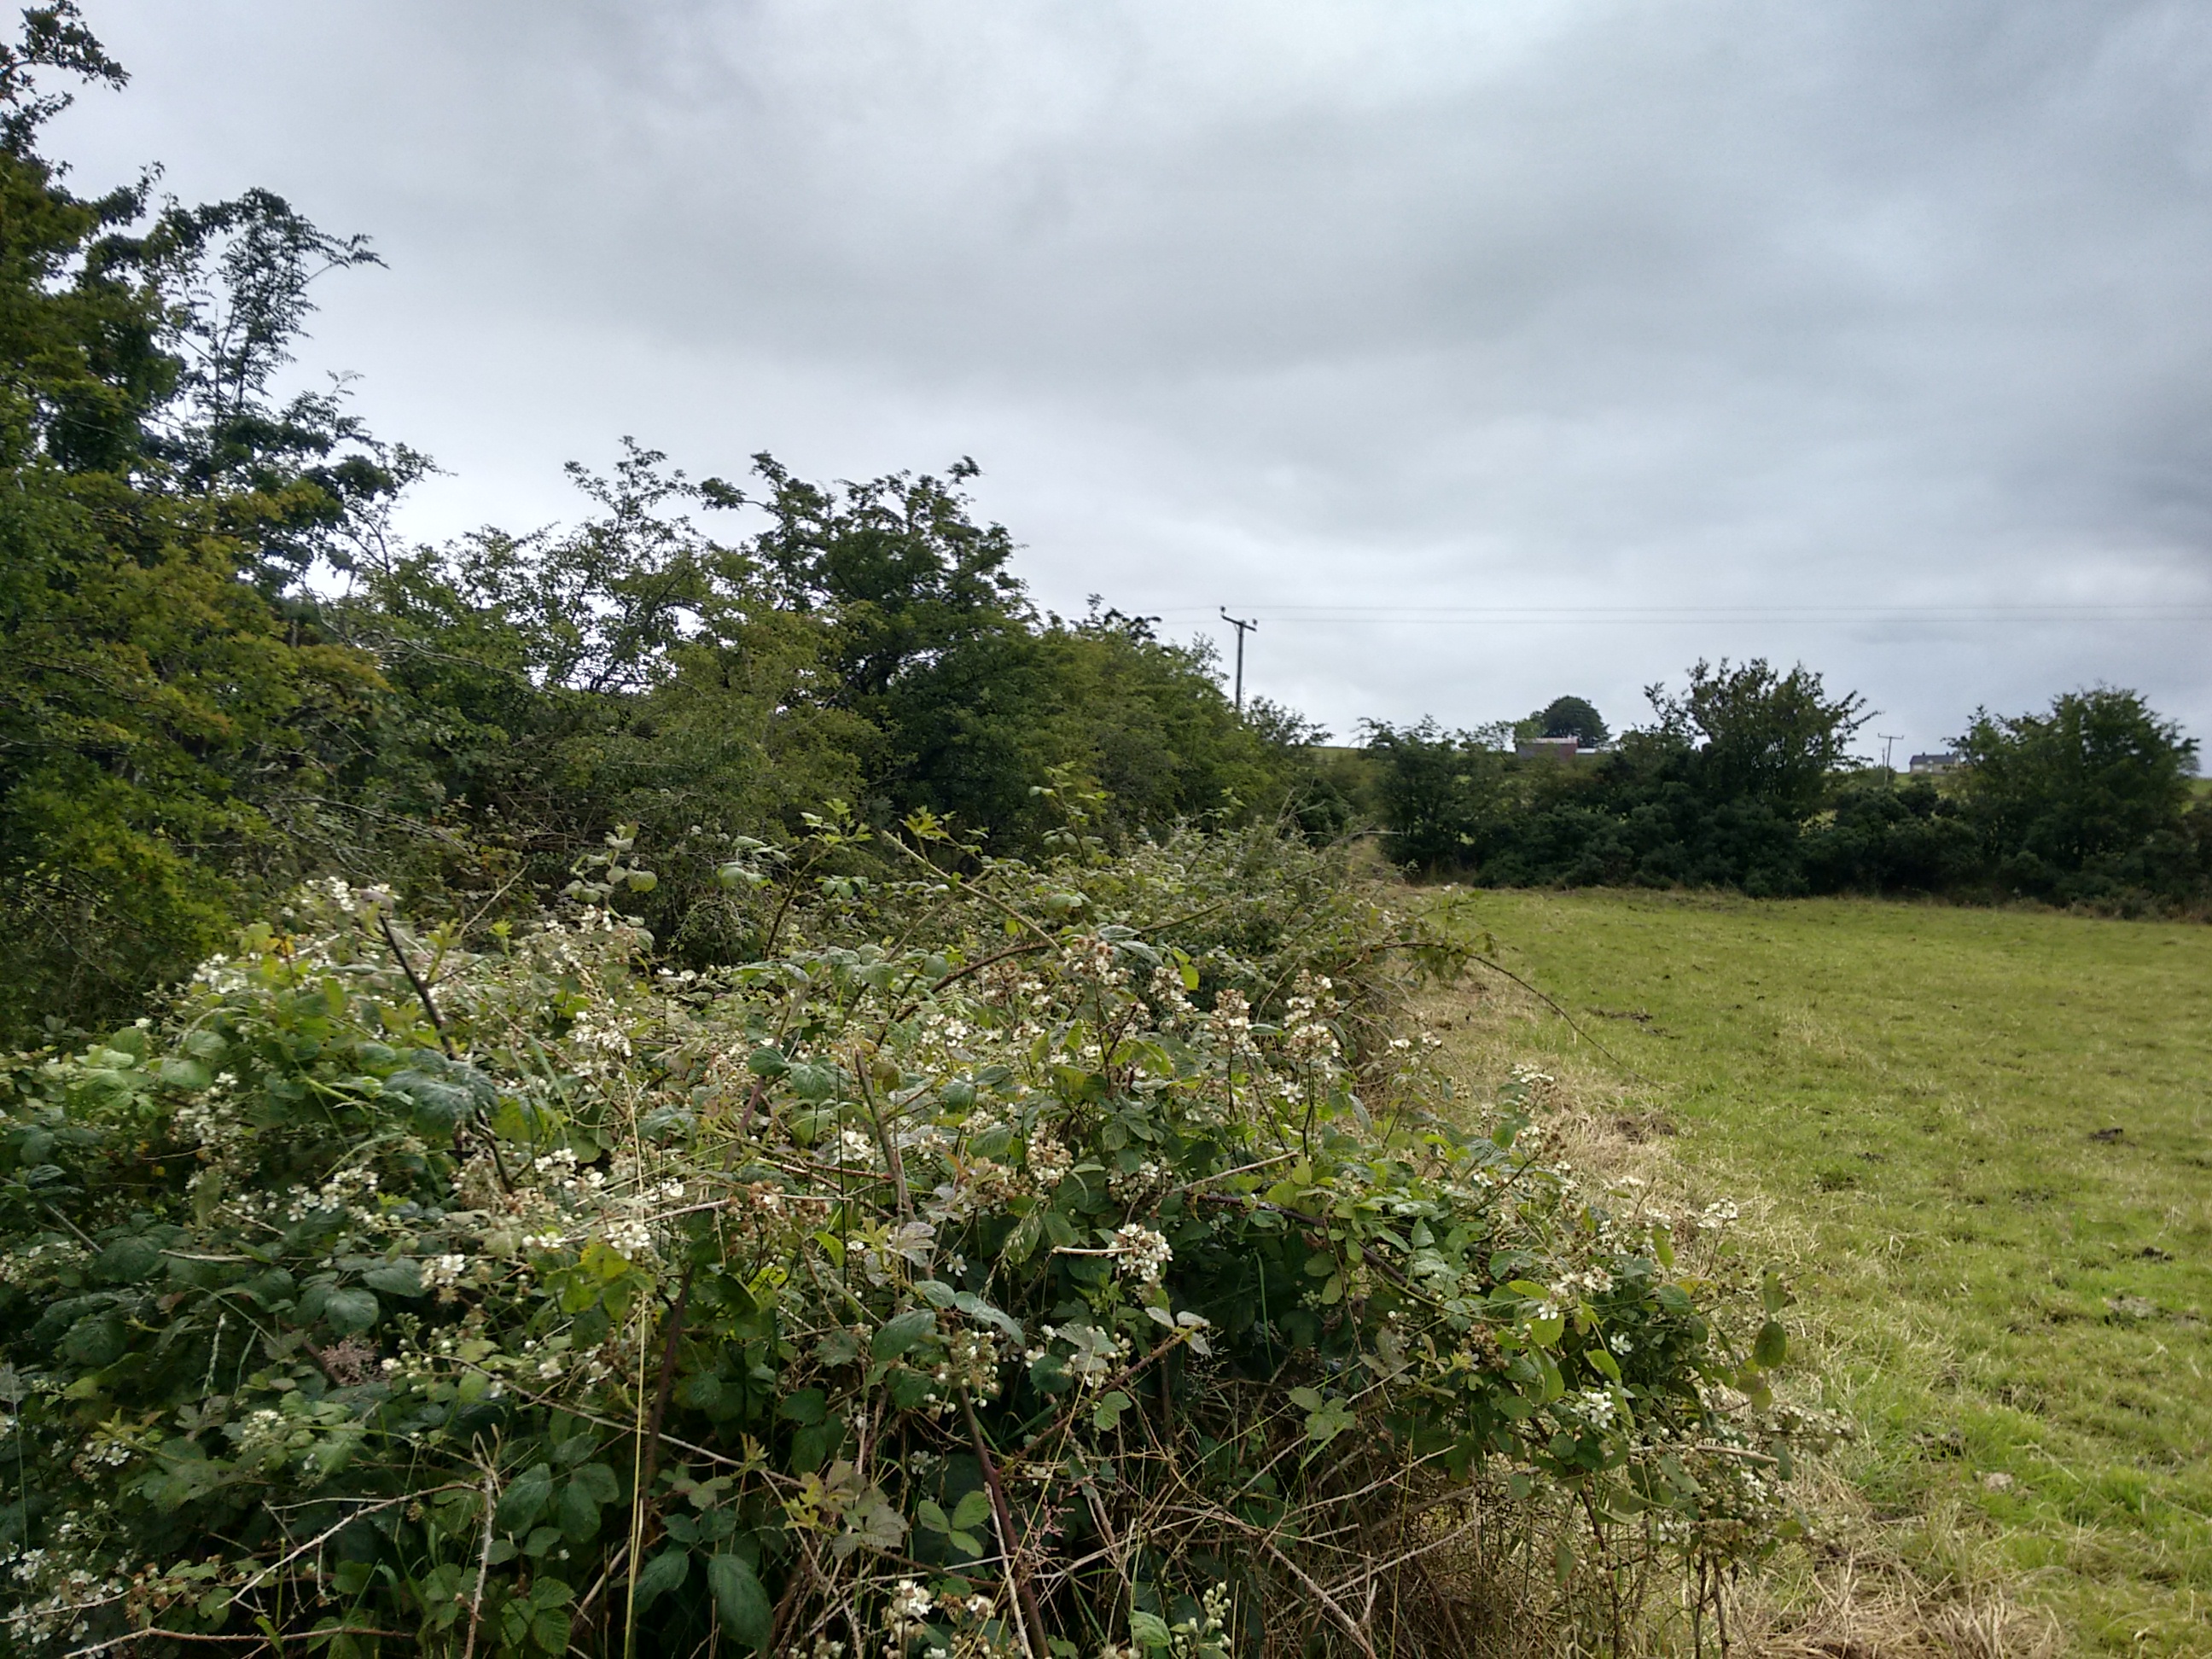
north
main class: Grassland
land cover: Grassland without tree/shrub cover
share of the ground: > 75 %
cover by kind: herbaceous plants 100 %
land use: Agriculture (excluding fallow land and kitchen gardens)
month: July
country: GB
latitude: 54.4819
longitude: -7.0418
